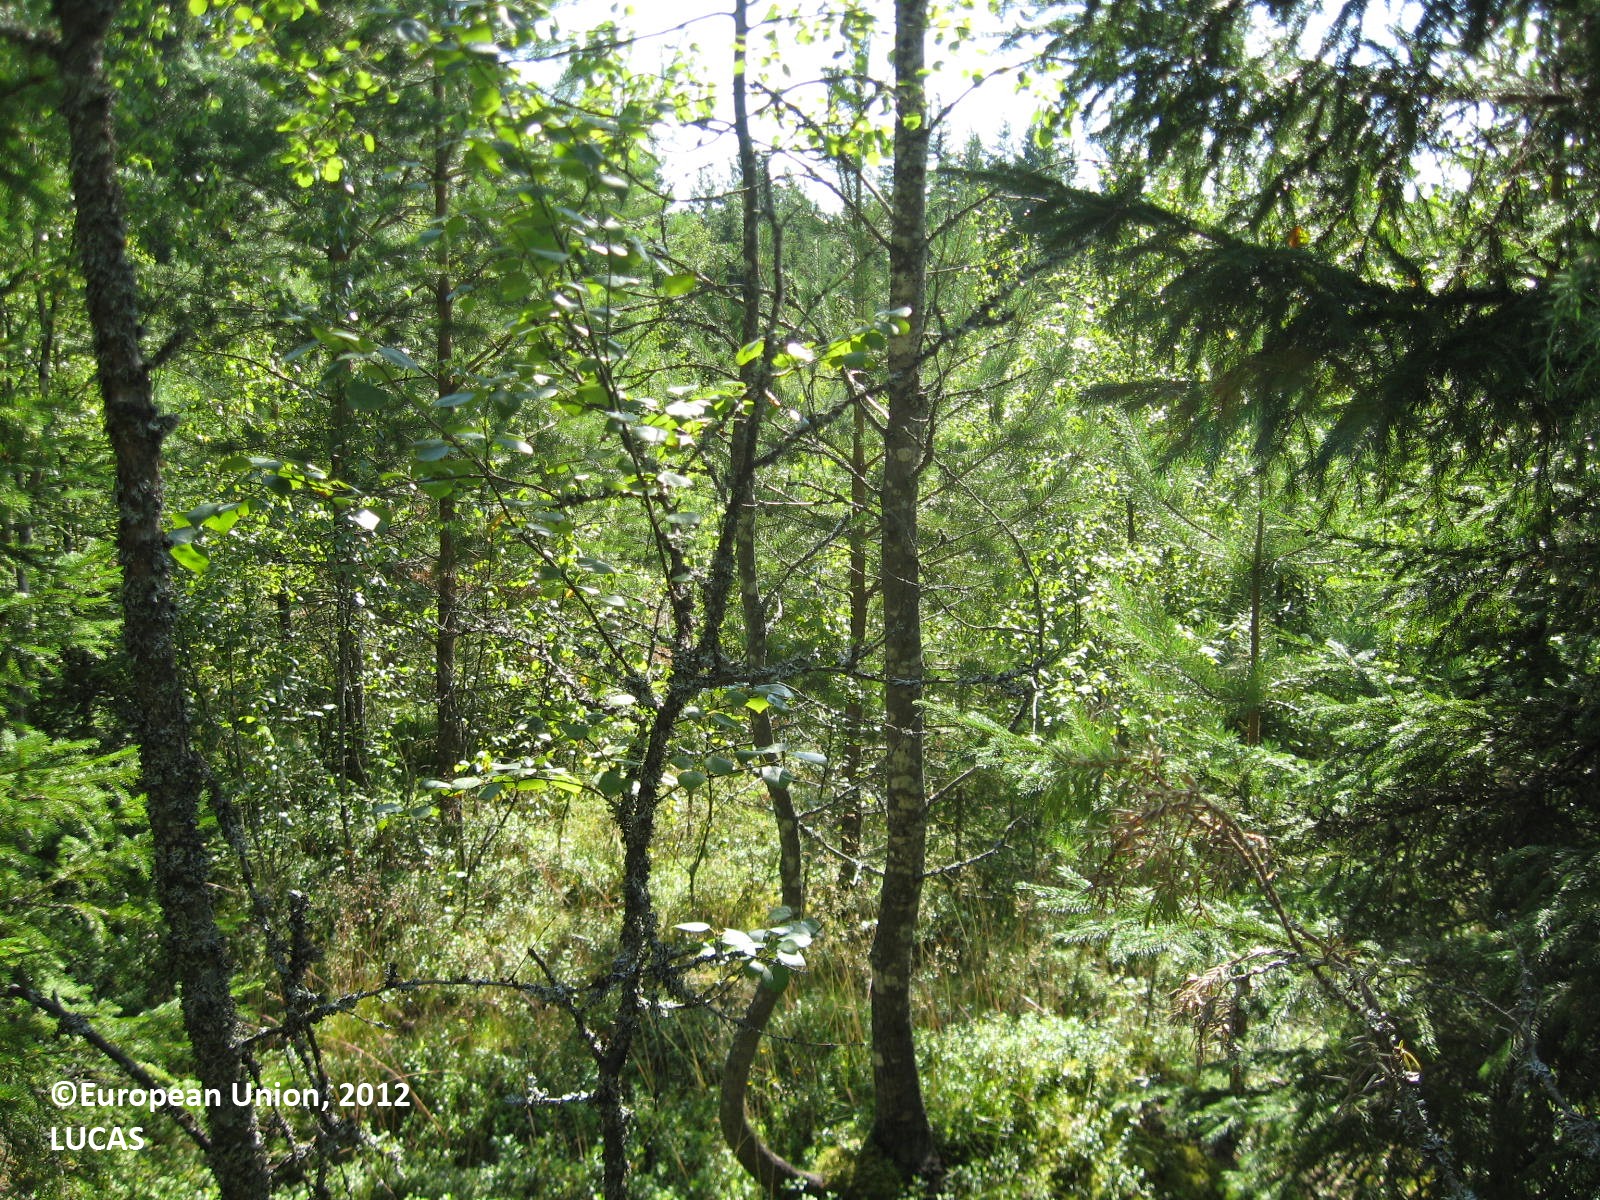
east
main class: Woodland
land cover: Other mixed woodland
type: boreal forest
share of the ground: > 75 %
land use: Forestry
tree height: > 5 m
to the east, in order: Other mixed woodland; Pine dominated coniferous woodland; Ditches and canals; Spruce dominated mixed woodland; Spruce dominated coniferous woodland
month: July
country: FI
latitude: 61.8652
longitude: 22.5509
